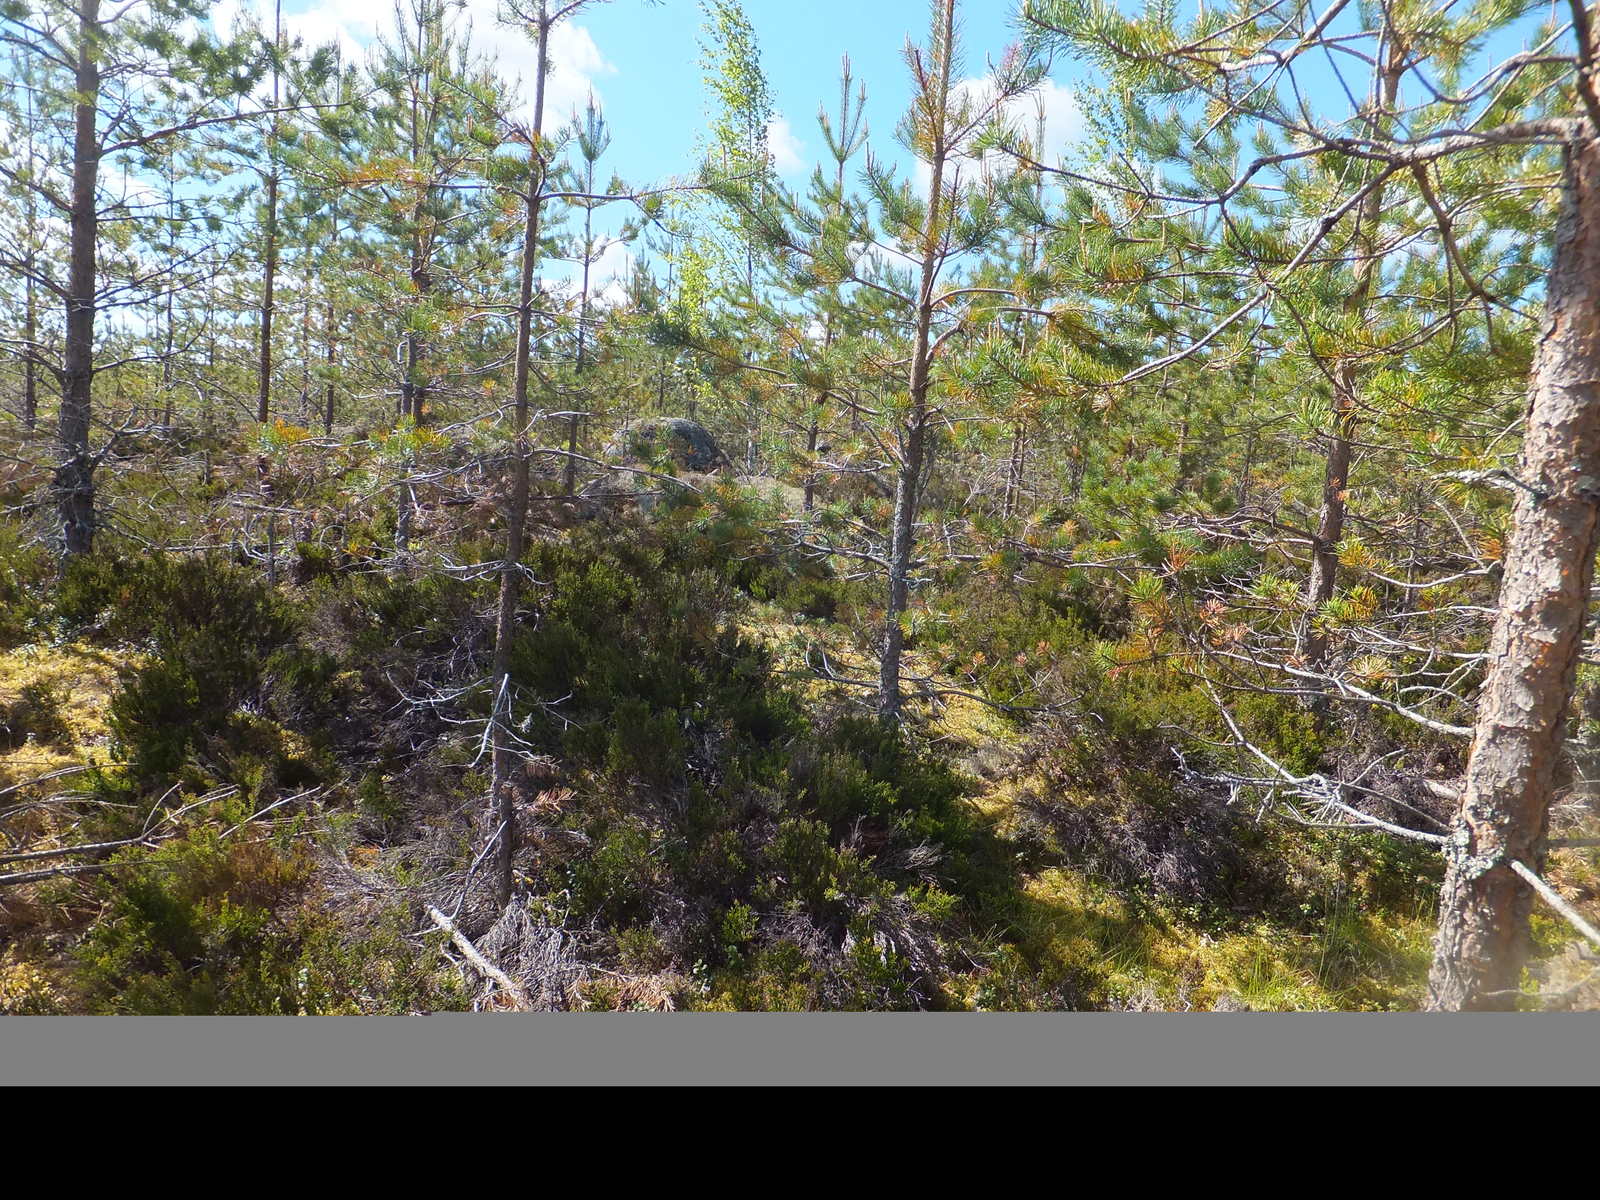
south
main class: Woodland
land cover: Pine dominated coniferous woodland
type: boreal forest
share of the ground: 50 - 75 %
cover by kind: coniferous forest trees 50 %, shrubs 30 %, broadleaved forest trees 10 %, lichens and mosses 10 %
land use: Forestry
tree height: < 5 m
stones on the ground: 10 - 25 %
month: June
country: FI
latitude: 63.4048
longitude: 22.9683
